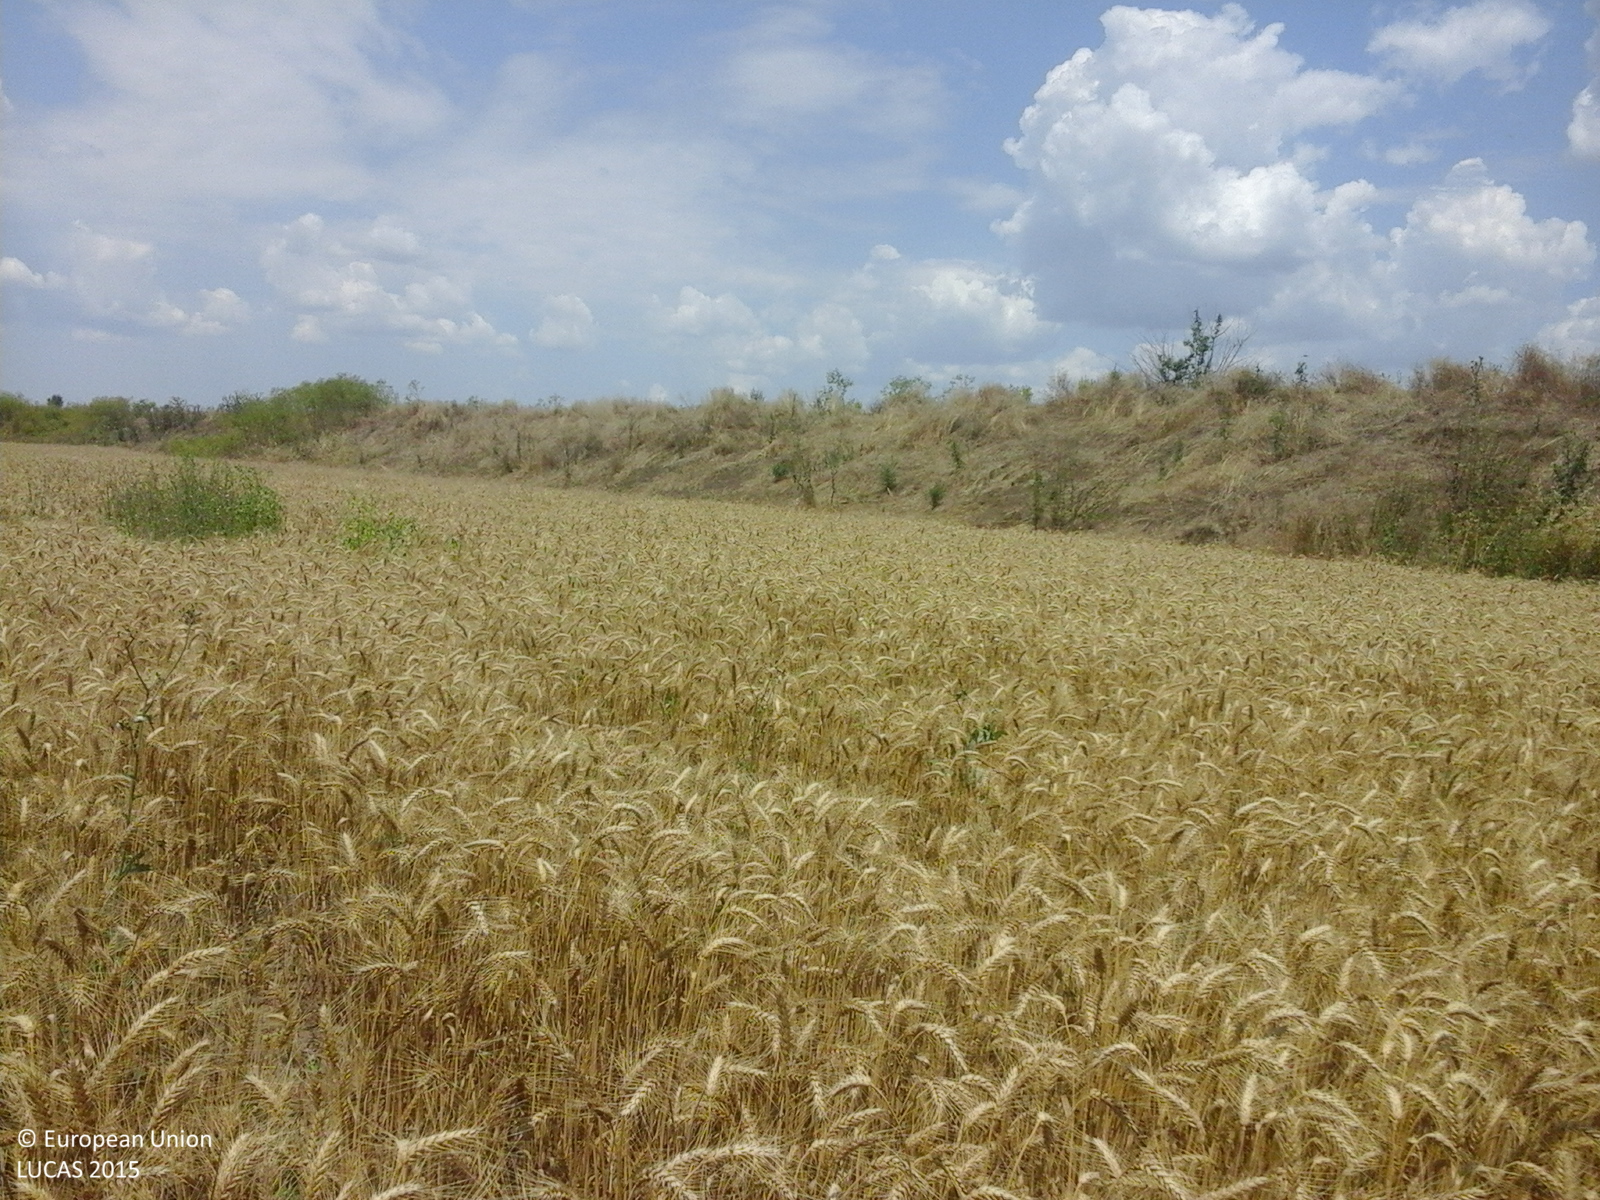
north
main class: Cropland
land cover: Common wheat
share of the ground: > 75 %
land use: Agriculture (excluding fallow land and kitchen gardens)
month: June
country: RO
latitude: 44.0889
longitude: 26.5872
